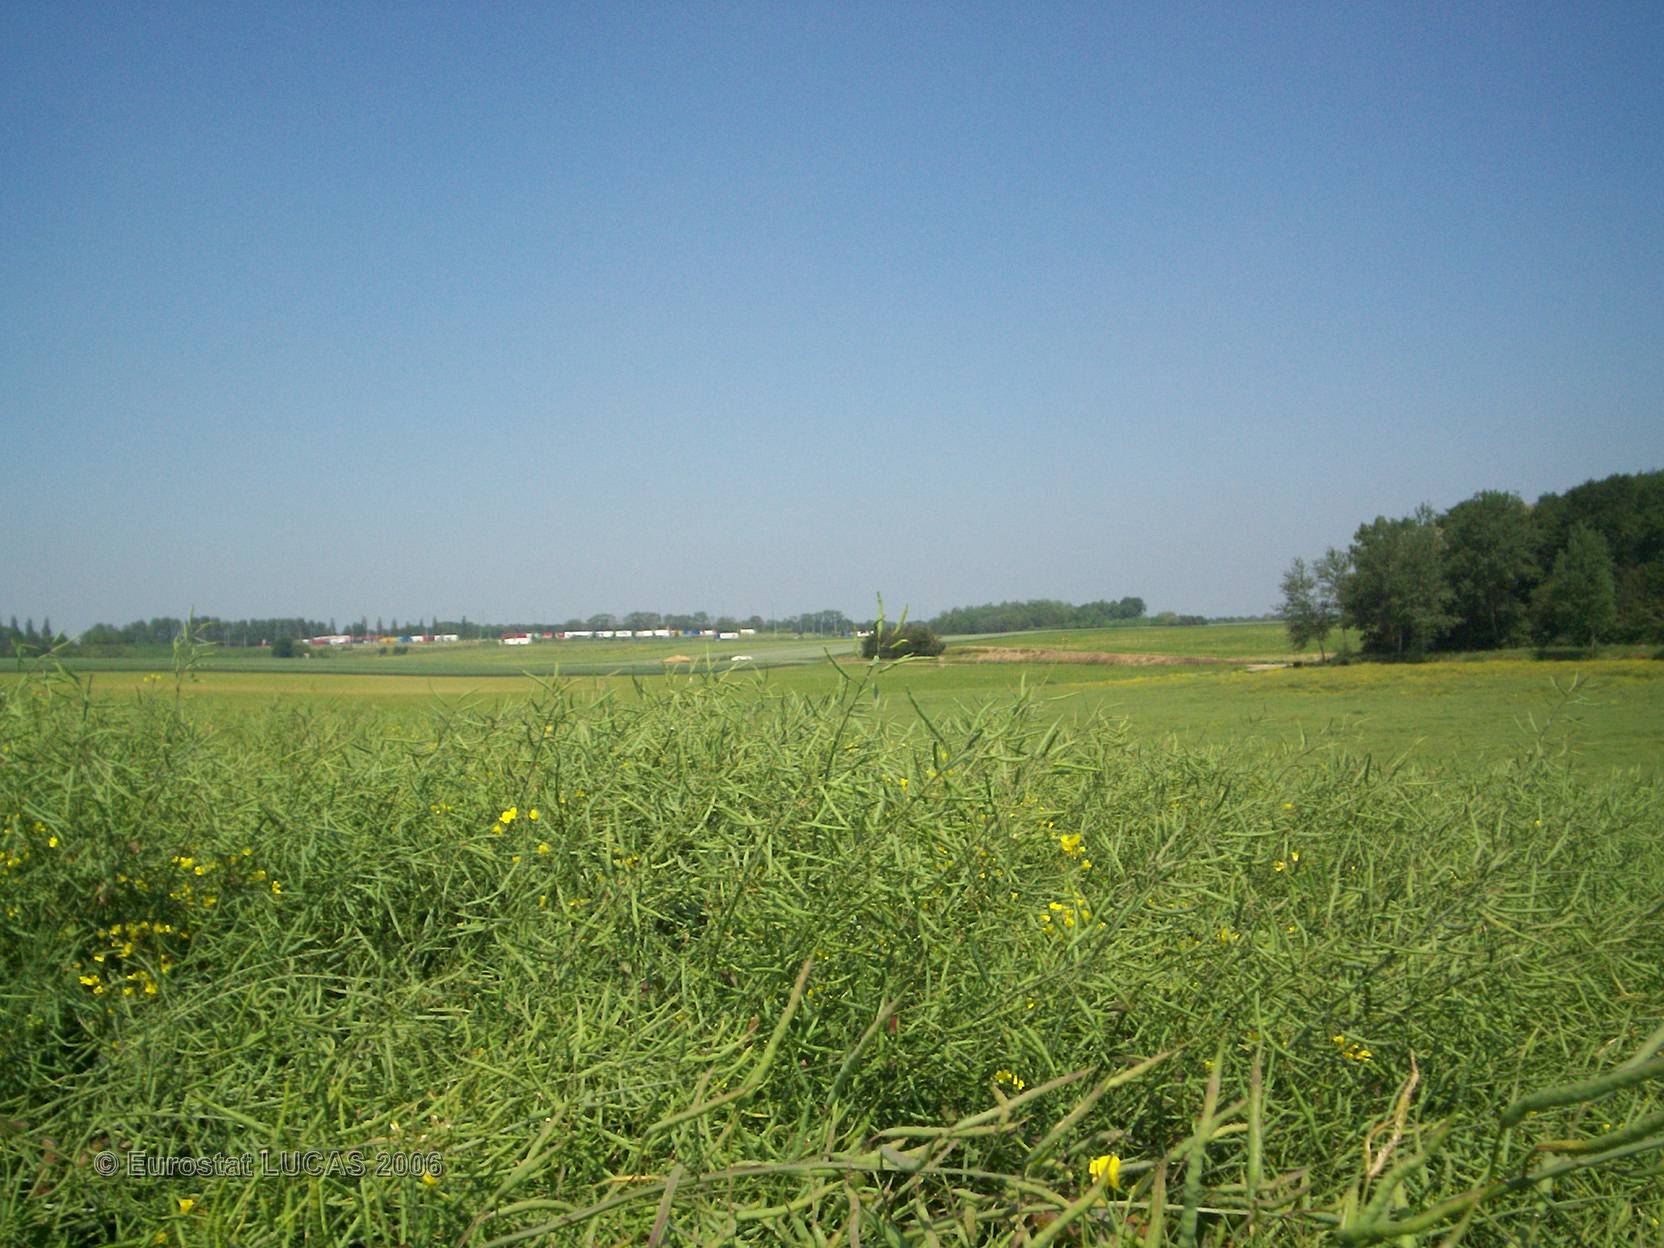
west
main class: Cropland
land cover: Rape and turnip rape
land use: Agriculture (excluding fallow land and kitchen gardens)
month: June
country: FR
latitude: 49.5191
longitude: 2.7372
